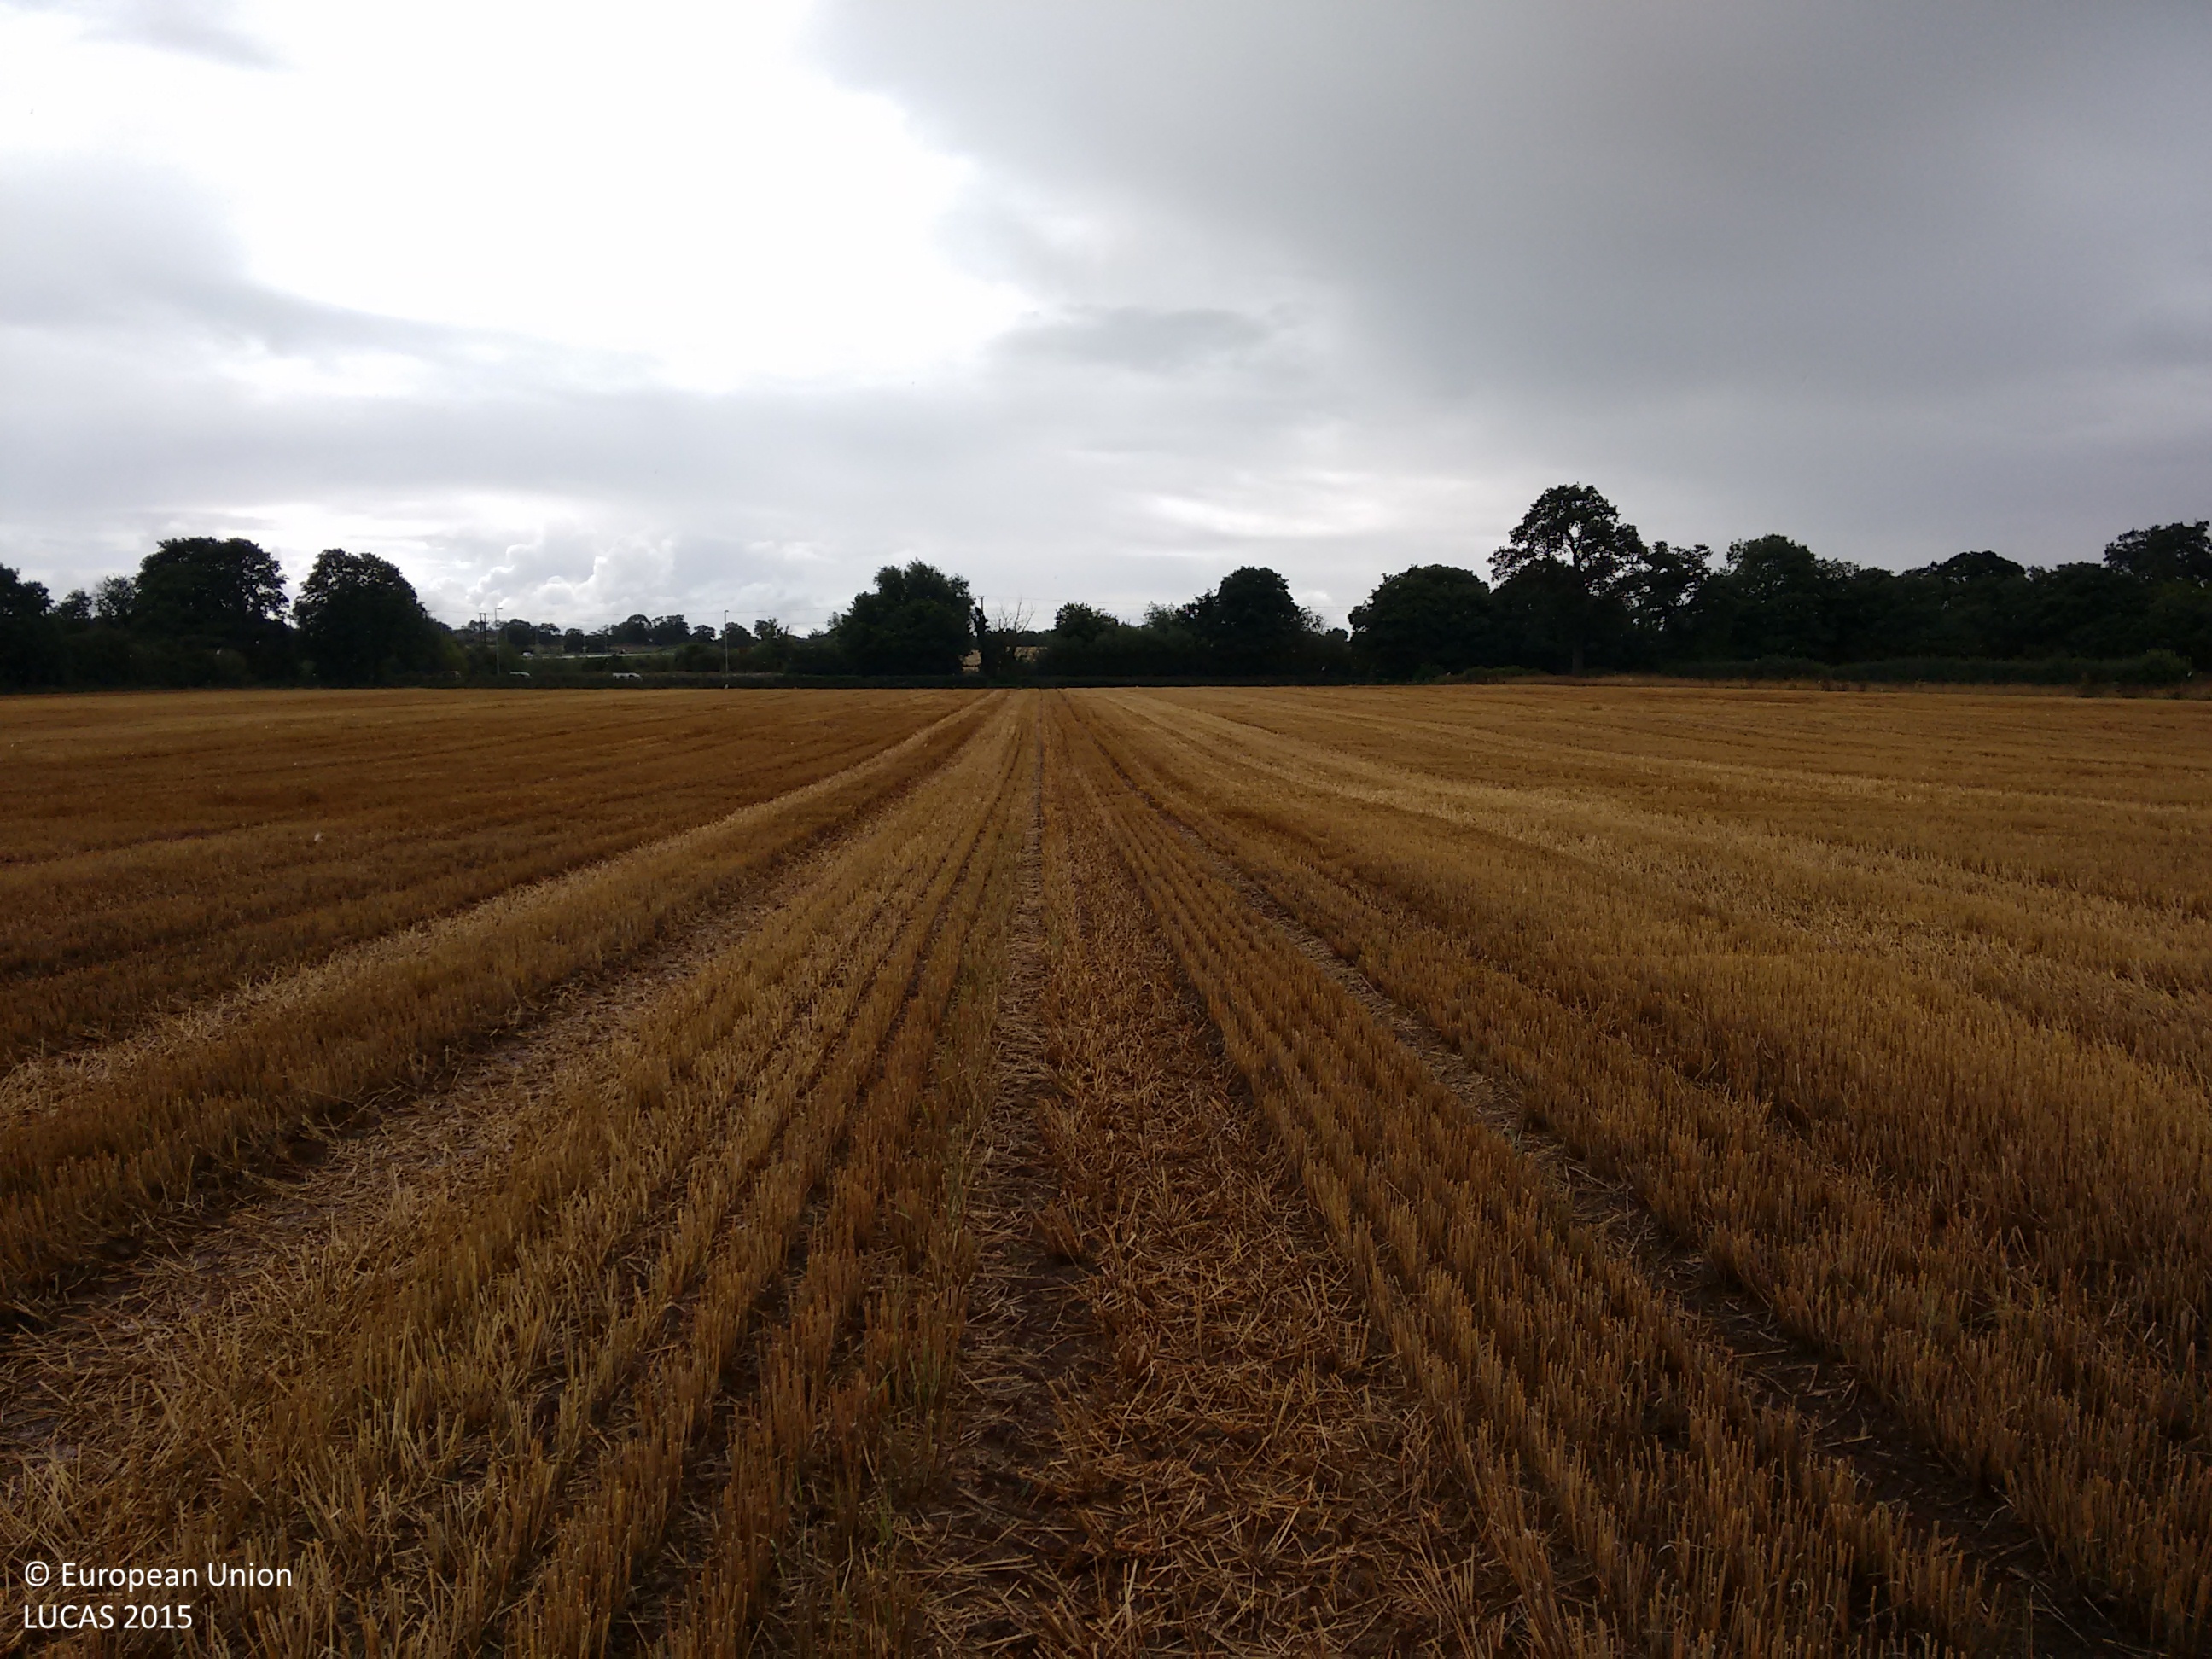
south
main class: Cropland
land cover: Barley
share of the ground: > 75 %
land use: Agriculture (excluding fallow land and kitchen gardens)
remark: Harvested field
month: September
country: GB
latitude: 53.0316
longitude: -2.9422
